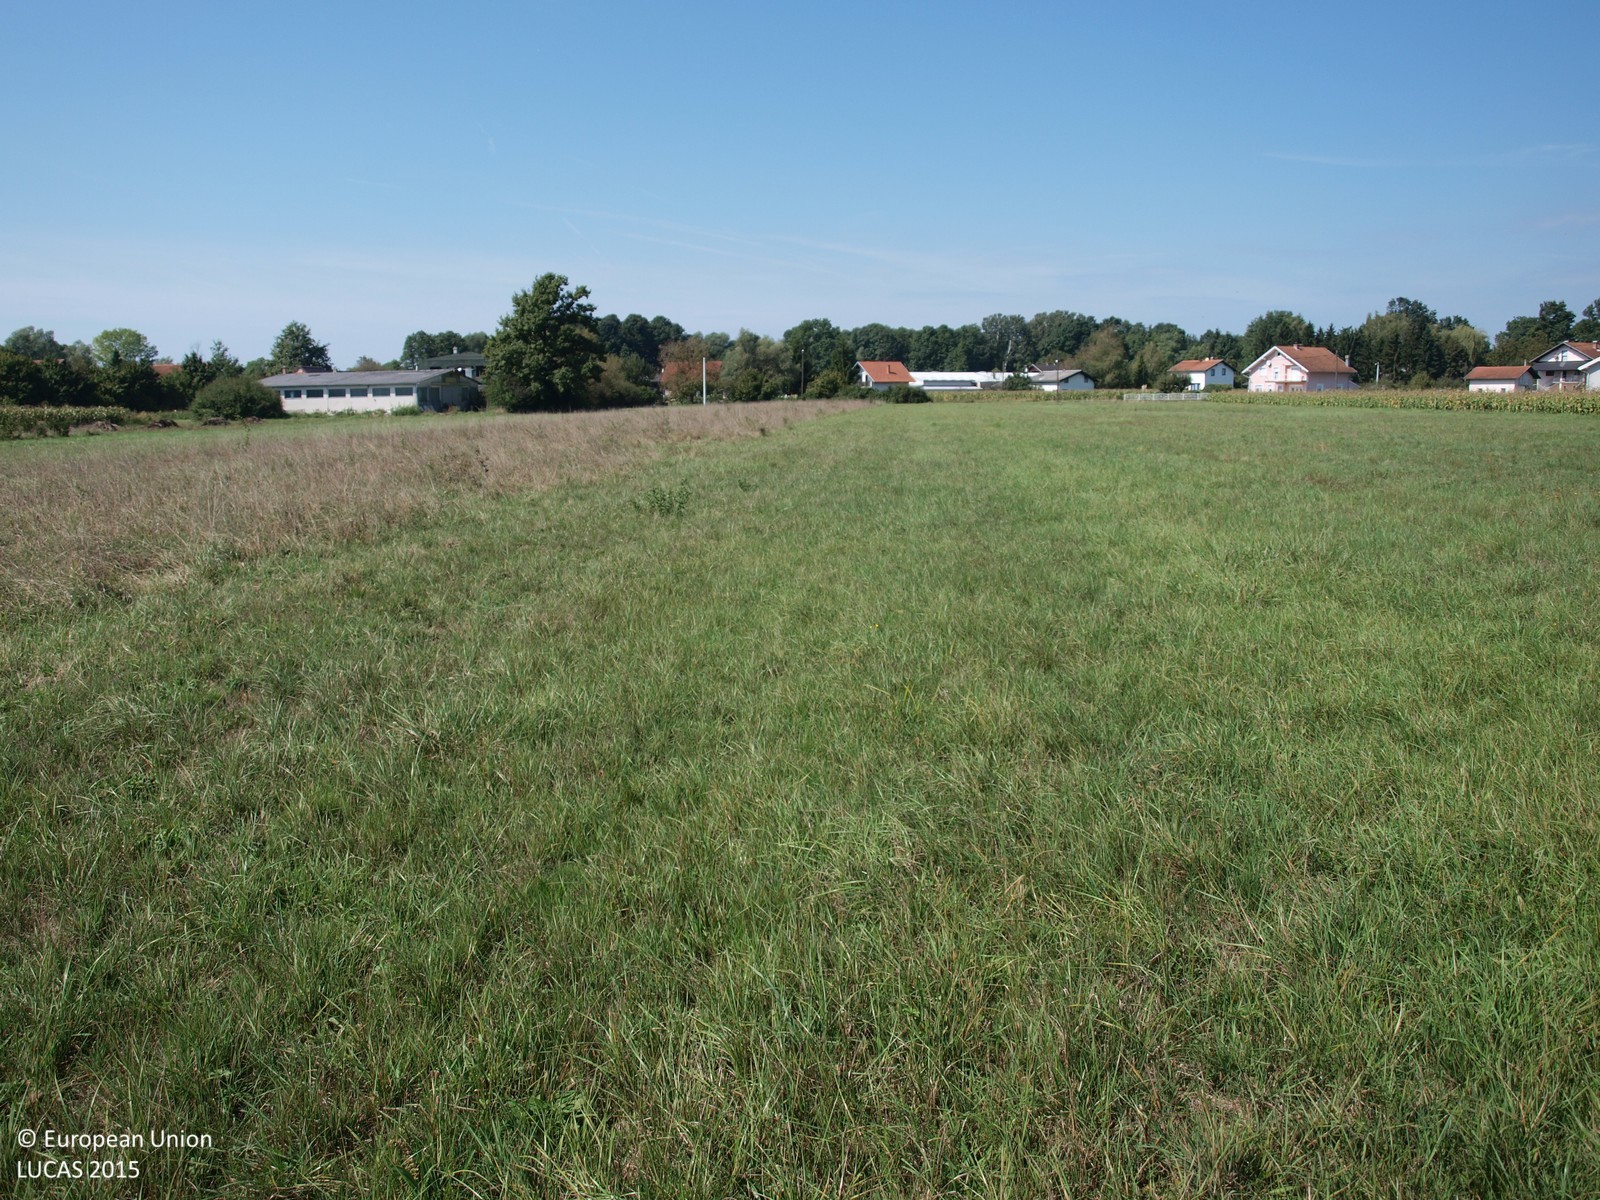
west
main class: Grassland
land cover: Grassland without tree/shrub cover
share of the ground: > 75 %
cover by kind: herbaceous plants 100 %
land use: Agriculture (excluding fallow land and kitchen gardens)
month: September
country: HR
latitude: 45.7045
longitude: 16.1503
